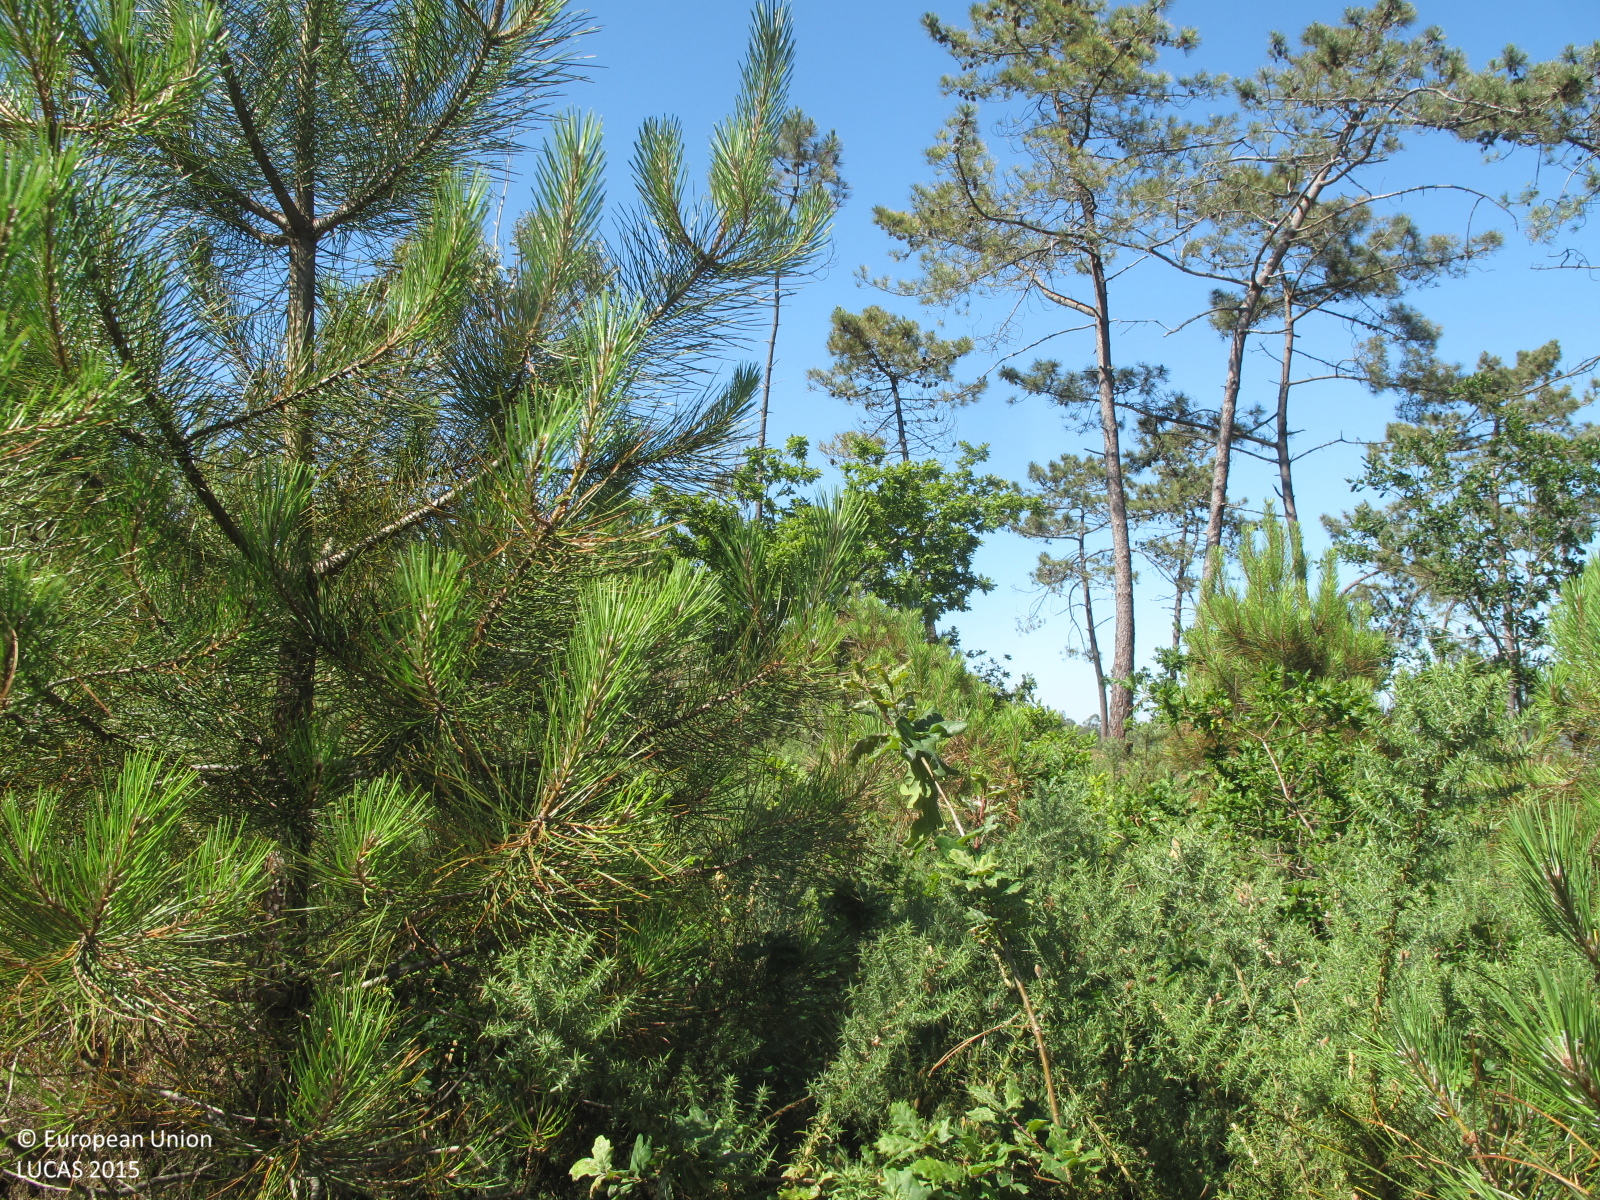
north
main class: Woodland
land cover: Pine dominated coniferous woodland
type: coniferous forest of the mediterranean region
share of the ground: 25 - 50 %
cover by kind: coniferous forest trees 40 %, herbaceous plants 30 %, shrubs 20 %, broadleaved forest trees 10 %
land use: Forestry
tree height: < 5 m
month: June
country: ES
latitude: 43.0414
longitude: -8.6834
